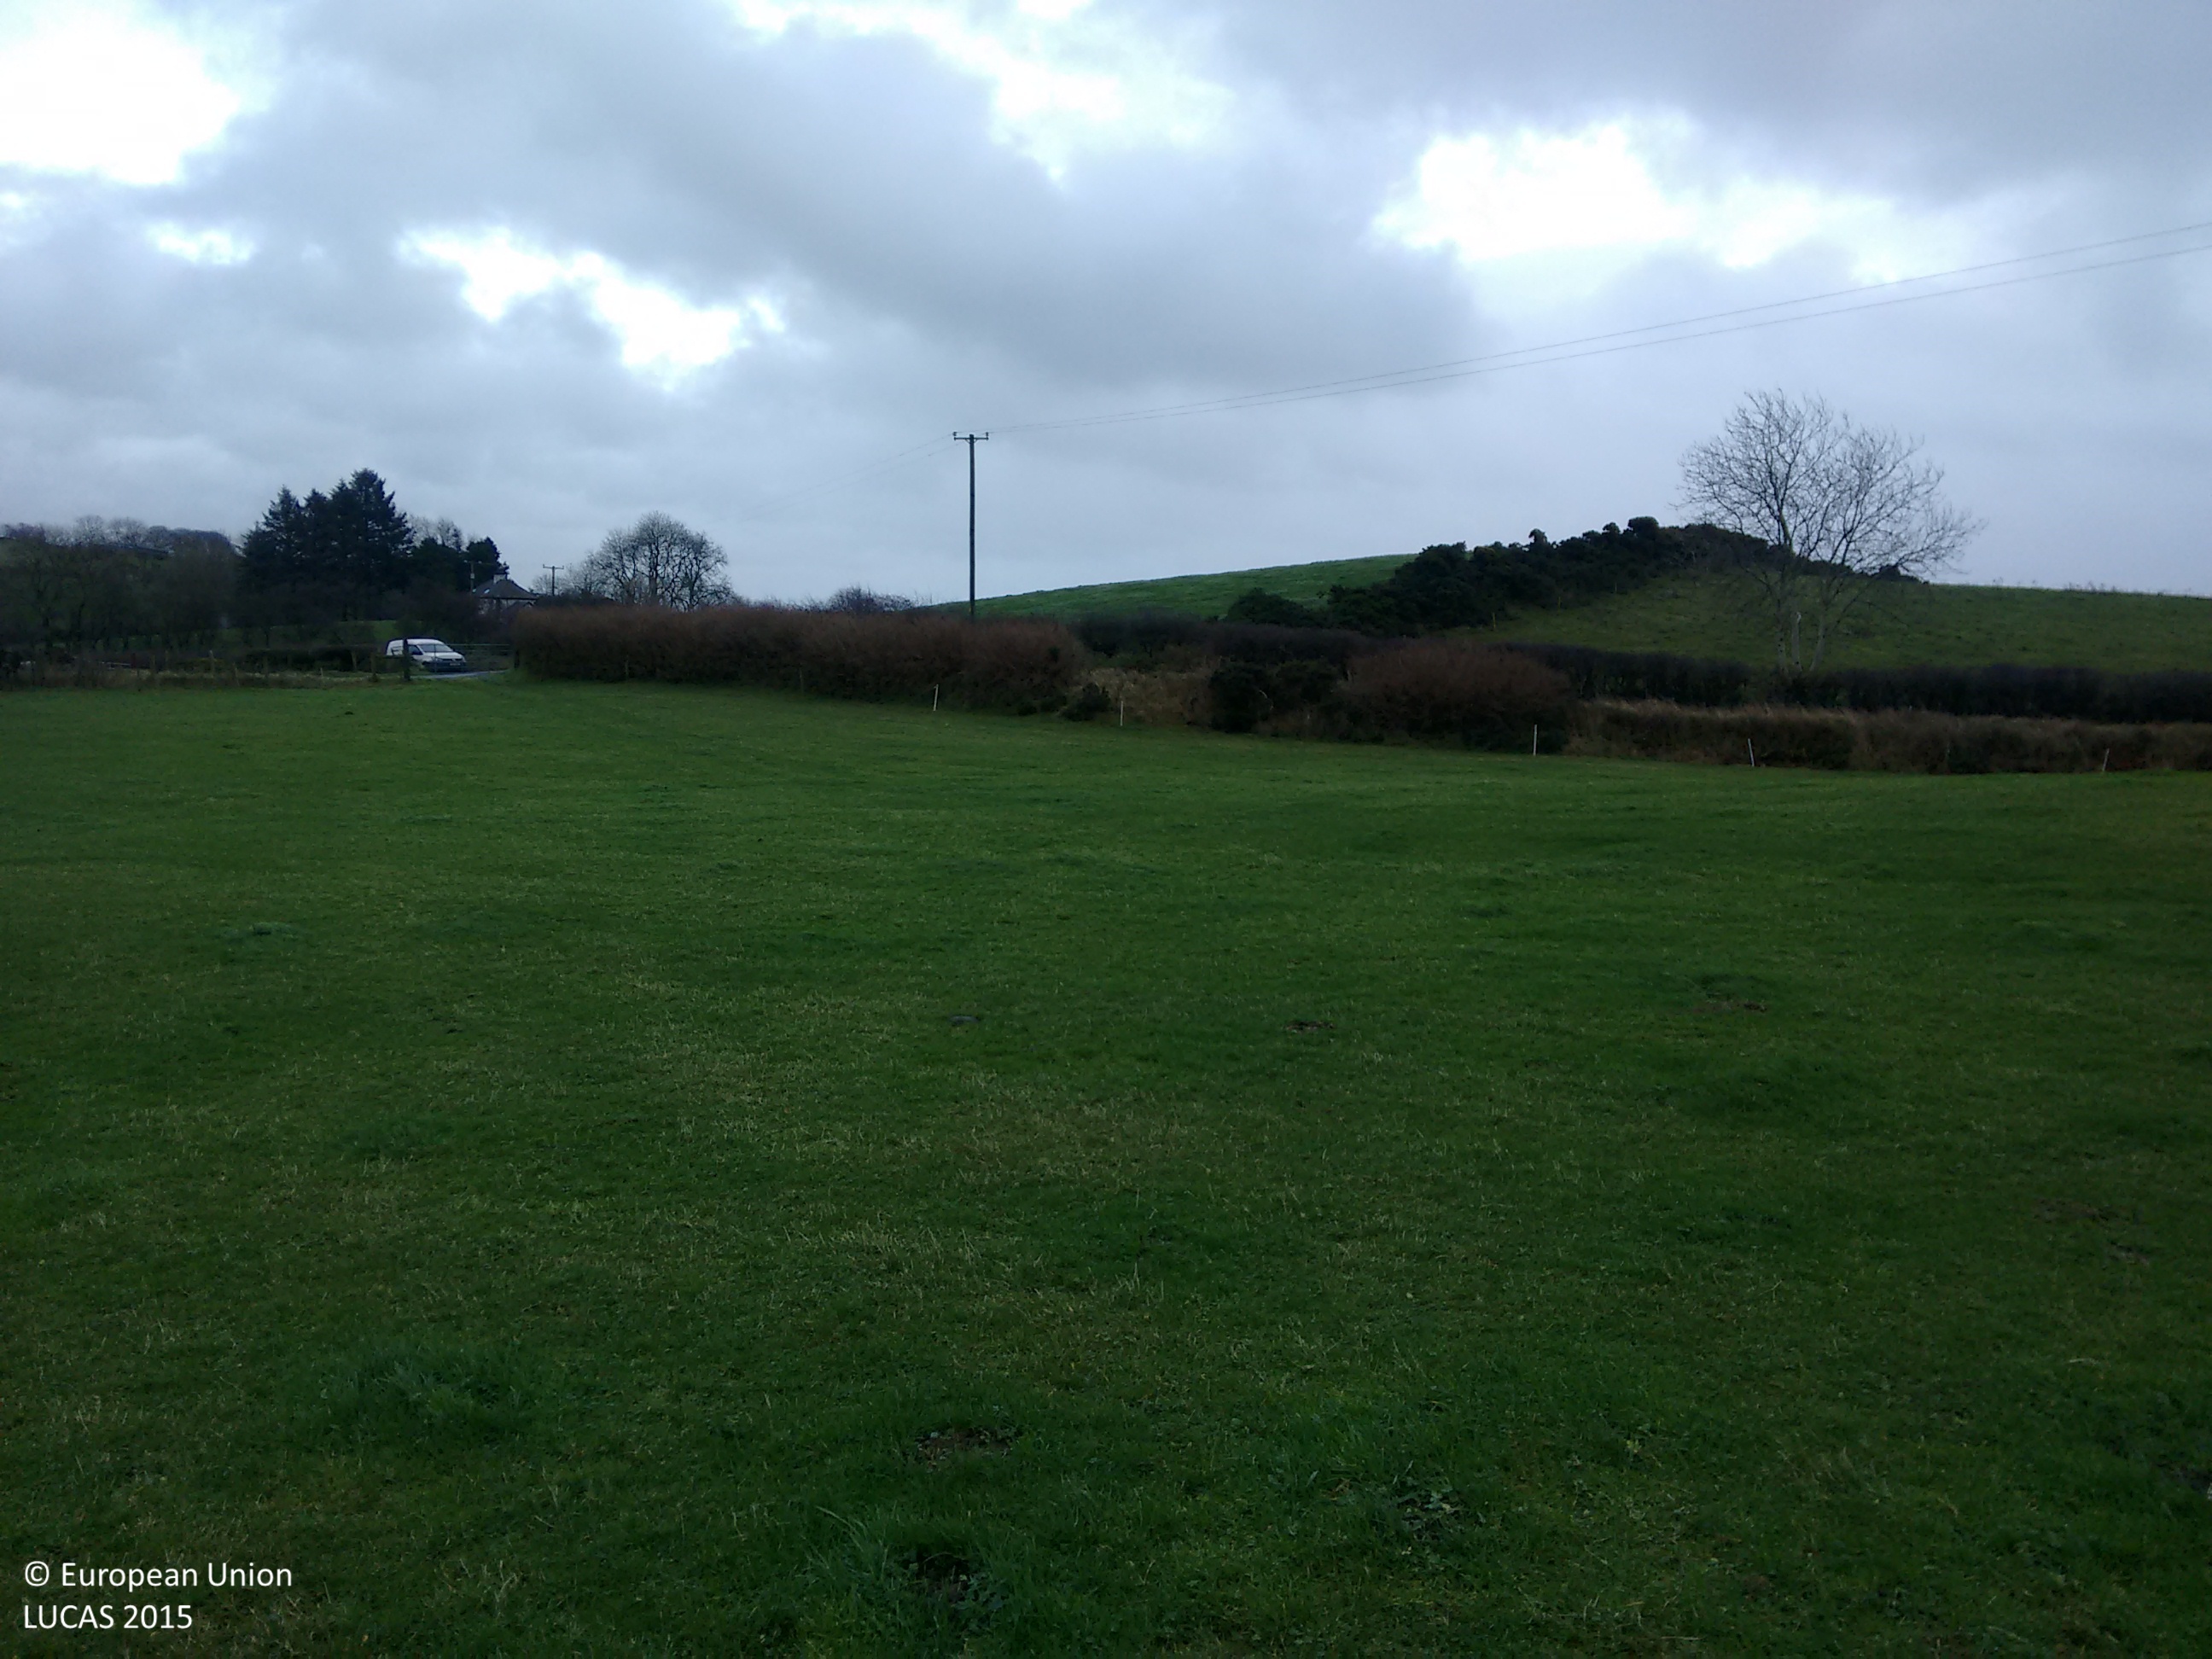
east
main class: Grassland
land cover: Grassland without tree/shrub cover
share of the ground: > 75 %
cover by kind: herbaceous plants 100 %
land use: Agriculture (excluding fallow land and kitchen gardens)
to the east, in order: Grassland without tree/shrub cover; Fences; Shruby margins; Fences; Grass margins; Electric lines; Paved roads, cycling and walking lanes; Shruby margins; Managed hedges; Fences; Grassland without tree/shrub cover
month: December
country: IE
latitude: 53.9342
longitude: -6.8767
